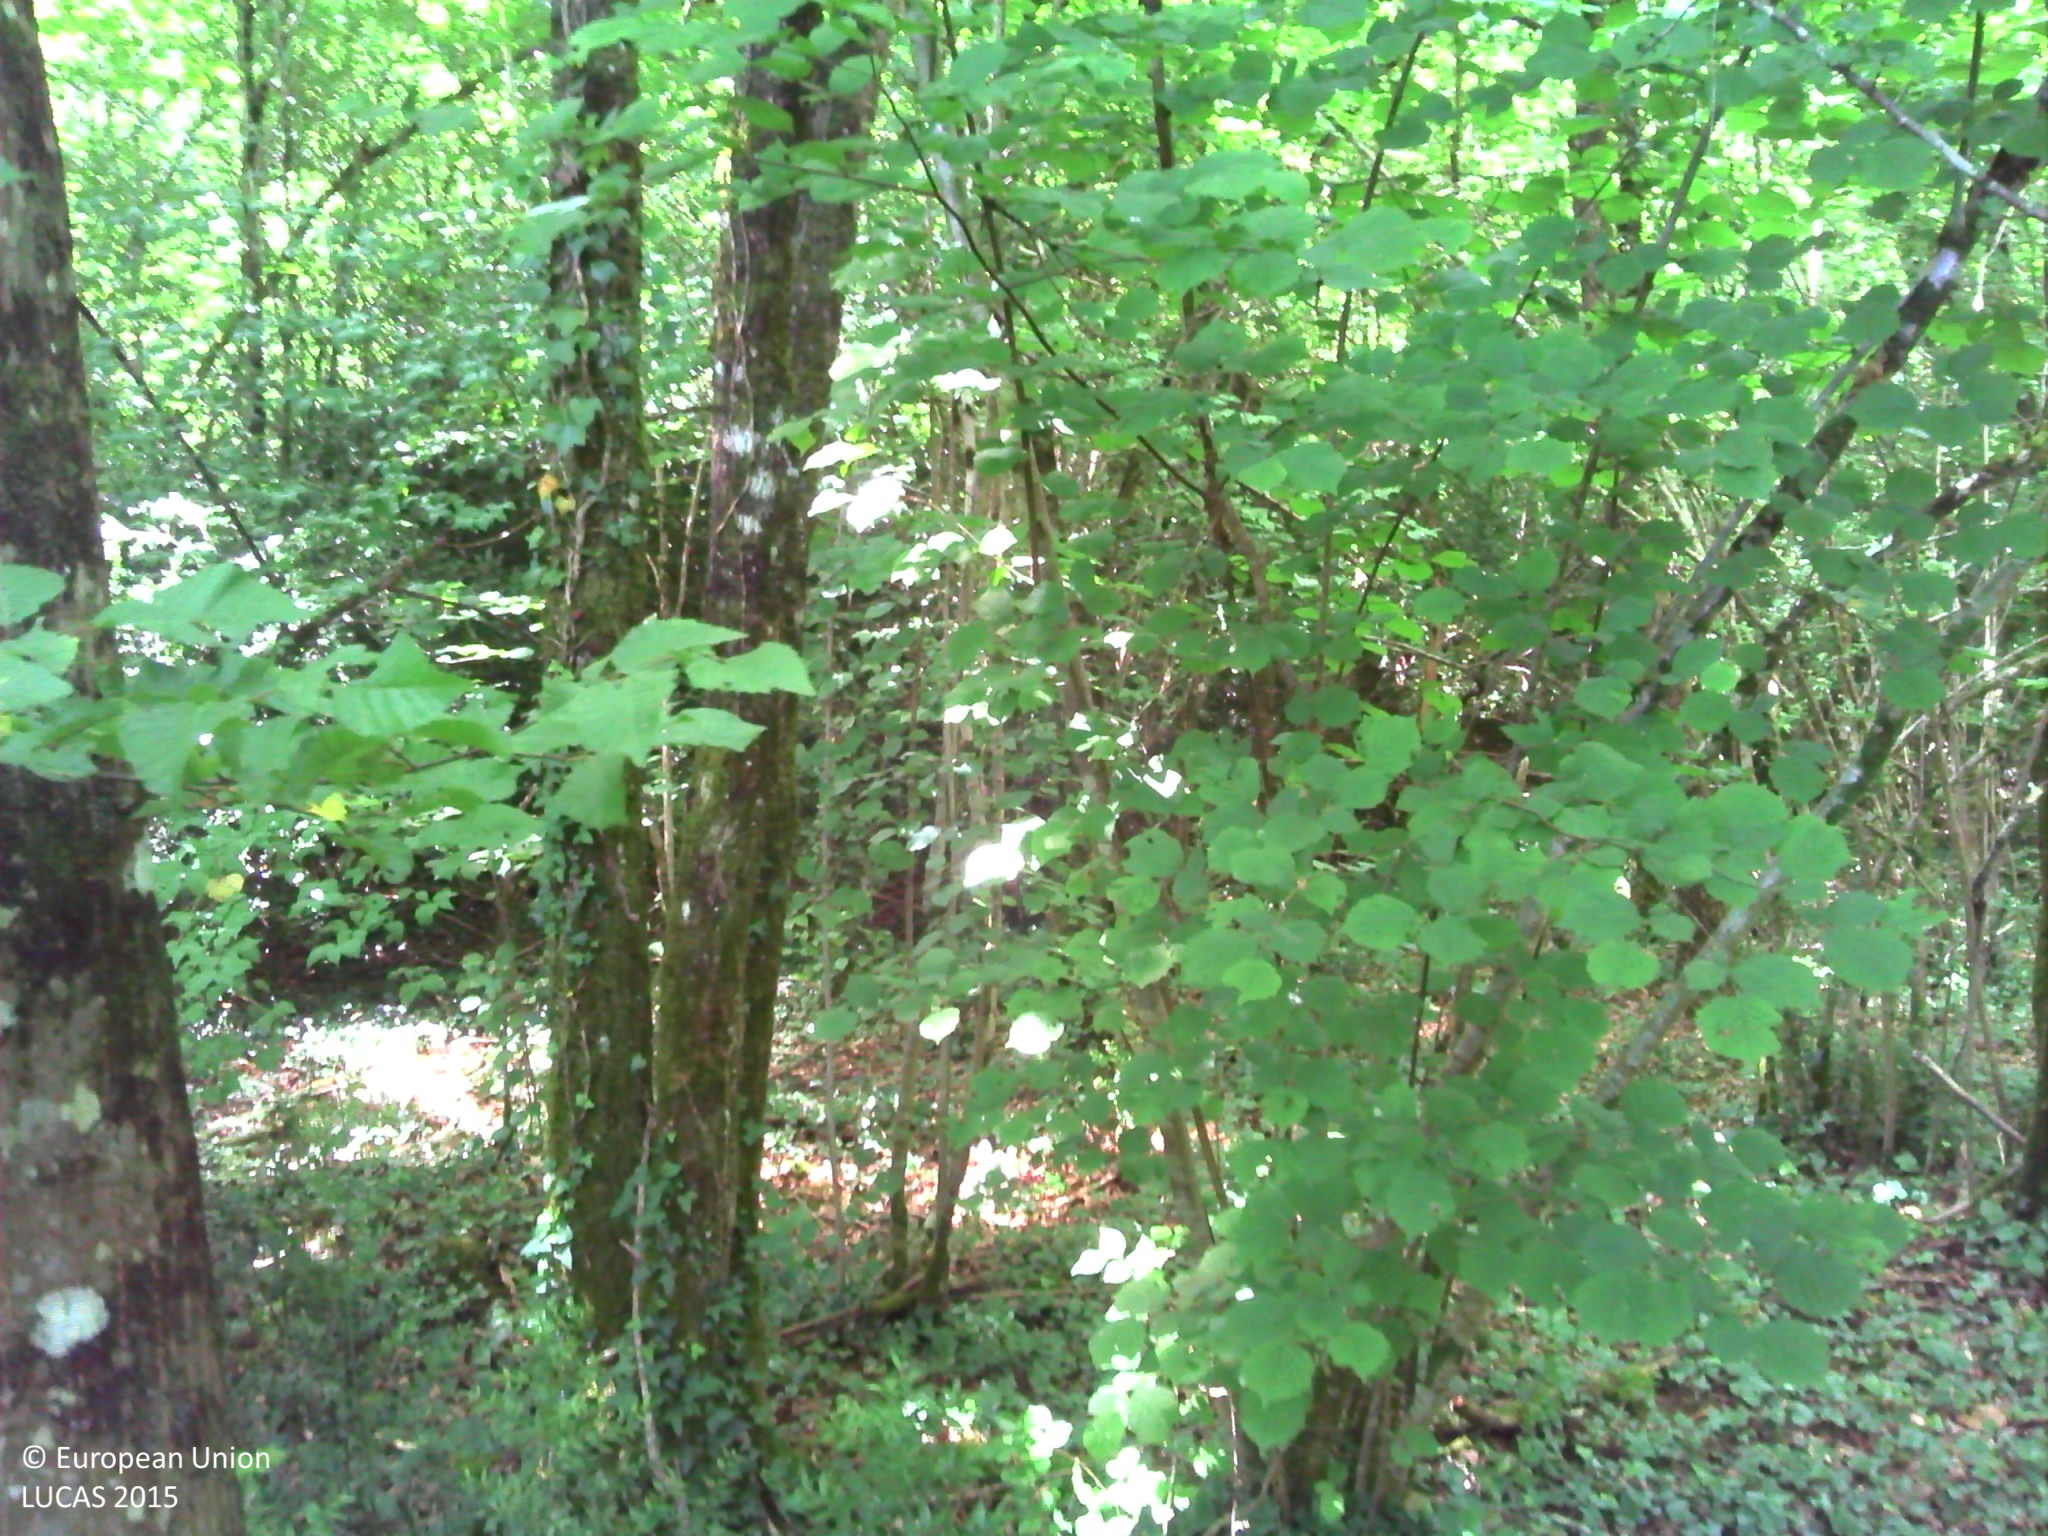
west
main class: Woodland
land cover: Broadleaved woodland
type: thermophilous deciduous forest
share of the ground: > 75 %
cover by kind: broadleaved forest trees 85 %, herbaceous plants 10 %, shrubs 5 %
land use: Forestry
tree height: > 5 m
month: June
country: FR
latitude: 45.7156
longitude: 0.3627
